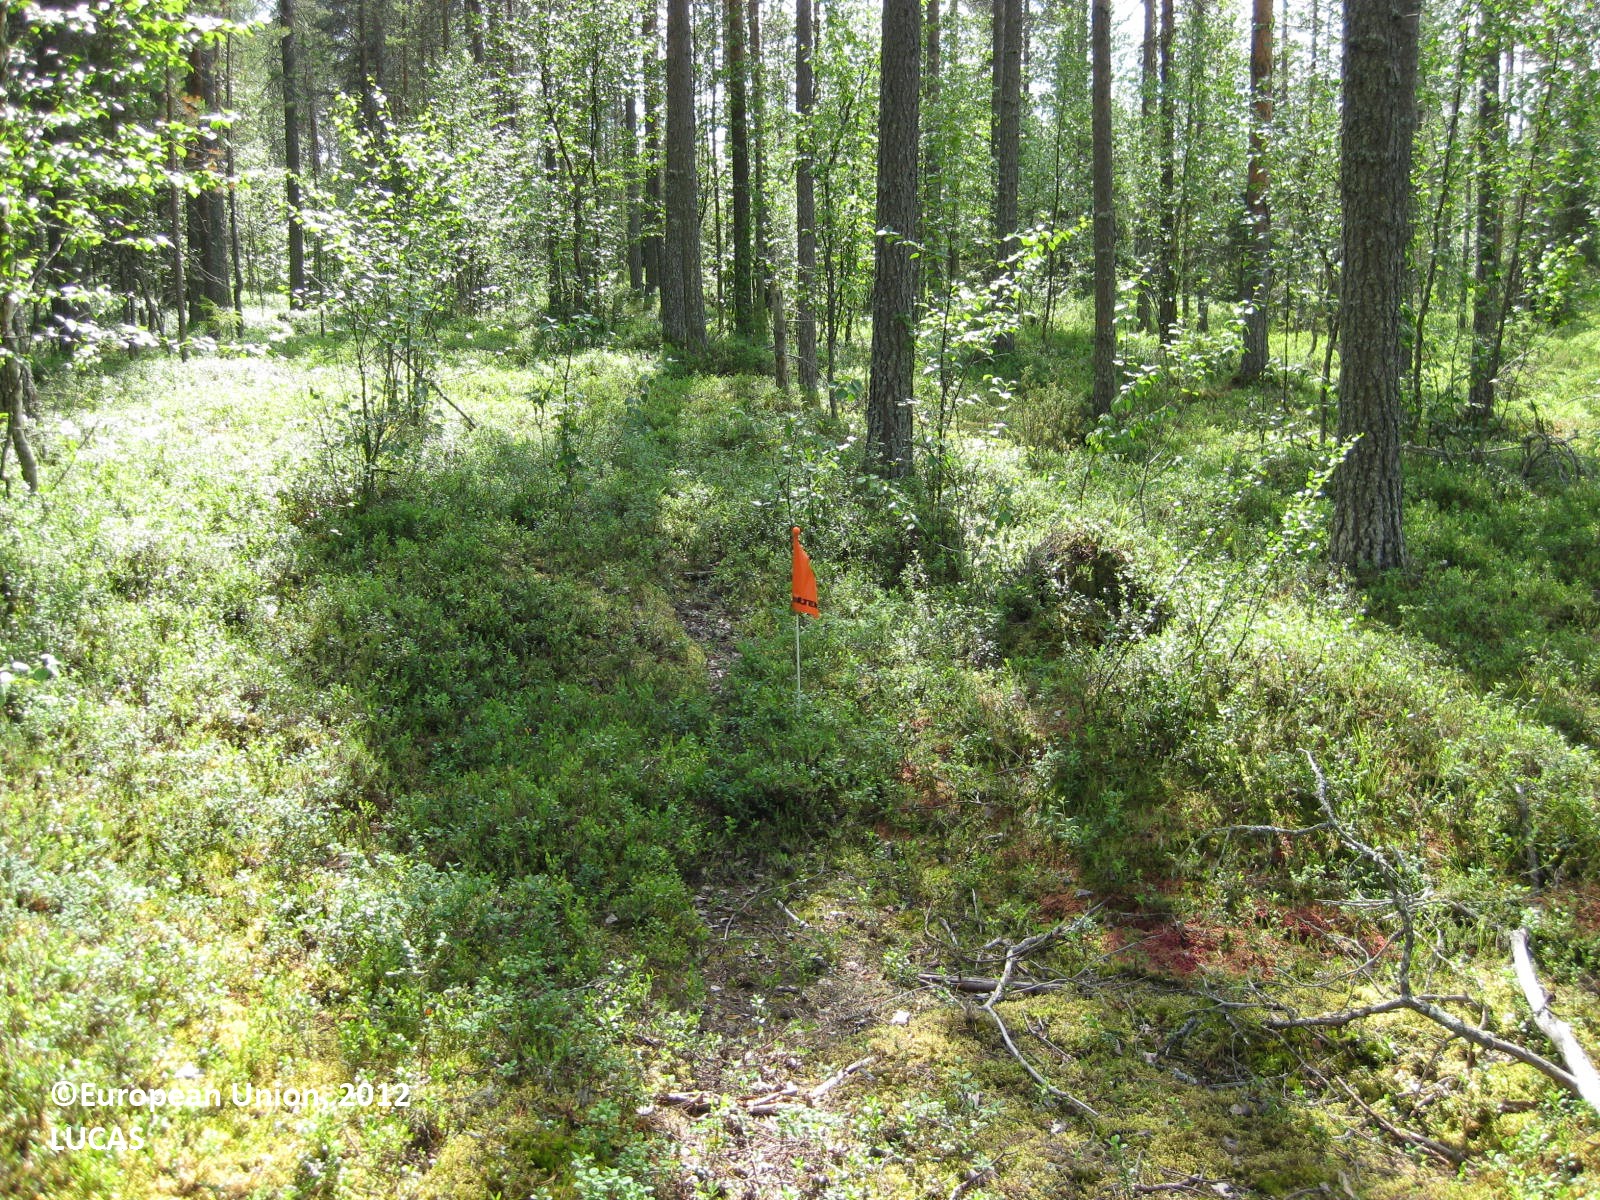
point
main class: Woodland
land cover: Pine dominated mixed woodland
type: boreal forest
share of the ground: 50 - 75 %
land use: Forestry
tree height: > 5 m
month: July
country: FI
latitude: 65.7023
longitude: 29.3332
